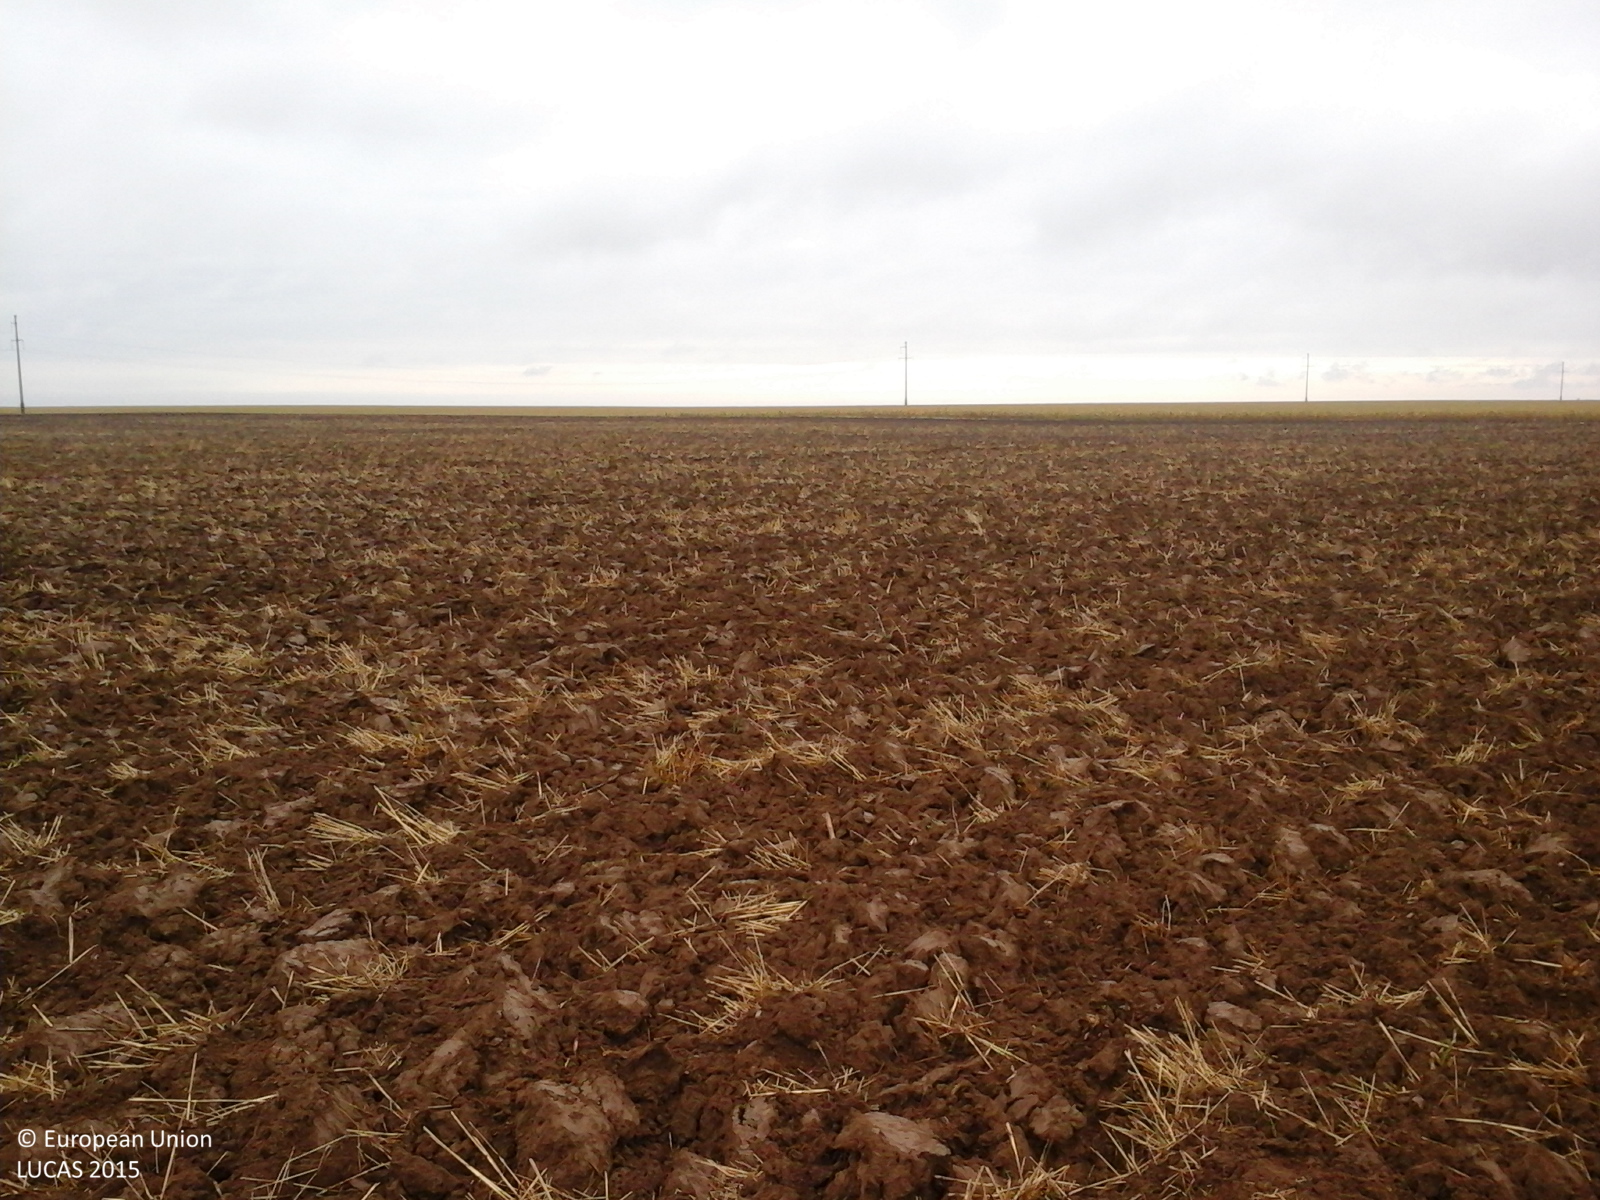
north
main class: Cropland
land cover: Common wheat
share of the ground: 10 - 25 %
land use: Agriculture (excluding fallow land and kitchen gardens)
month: September
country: RO
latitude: 46.9710
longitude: 21.7815
